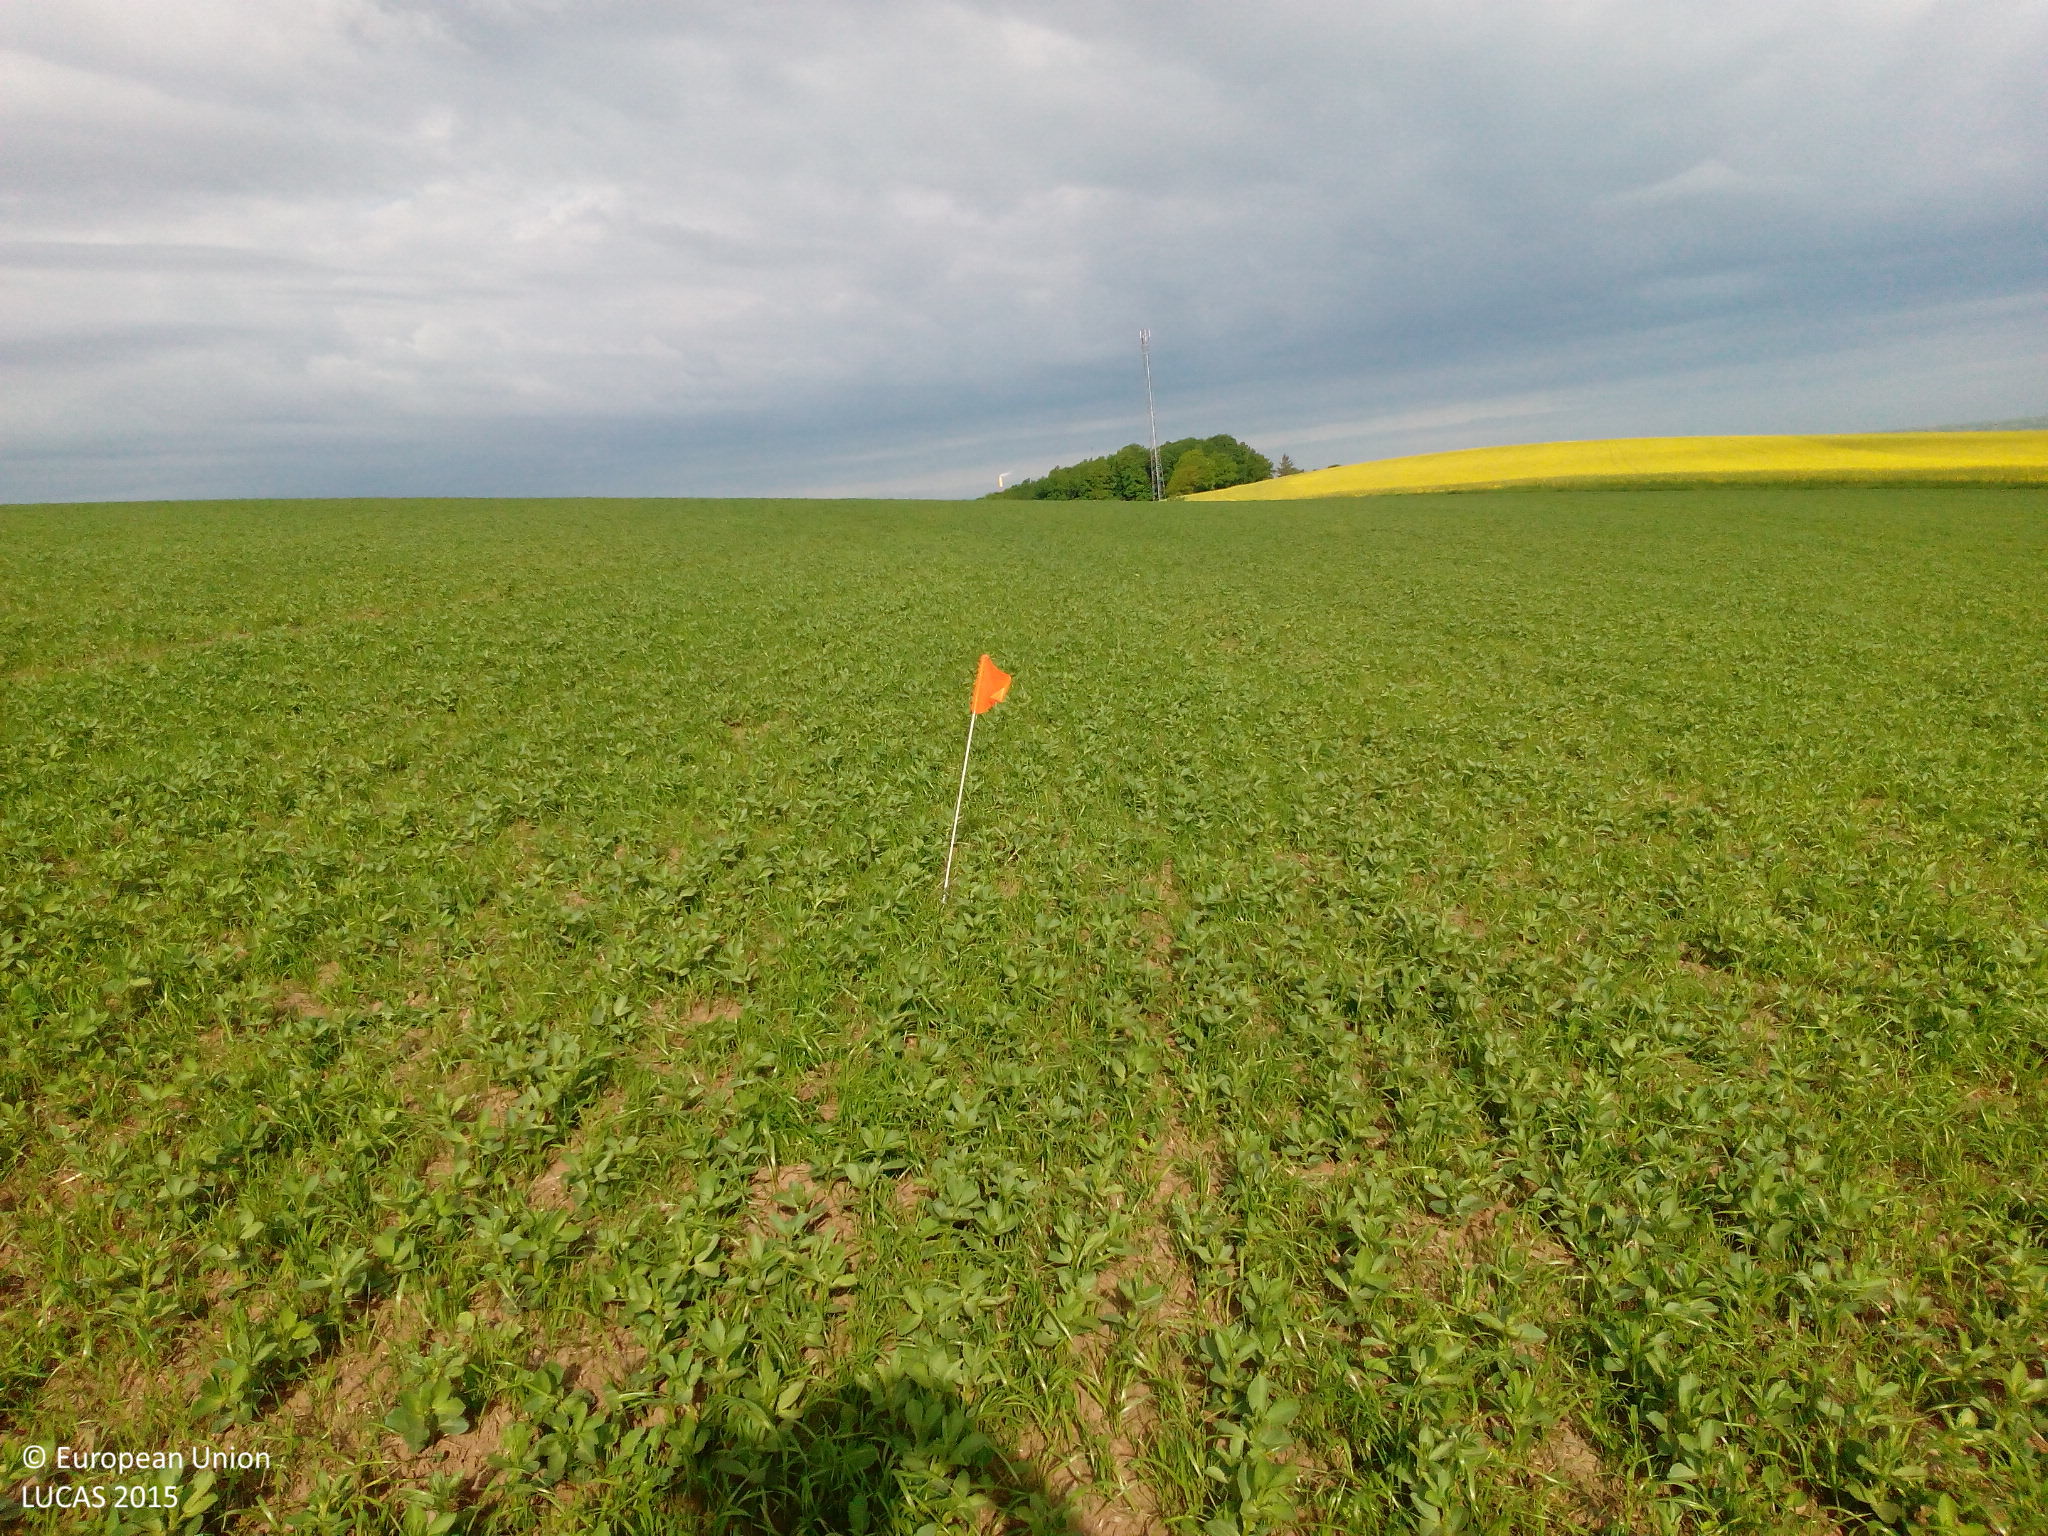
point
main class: Cropland
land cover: Sunflower
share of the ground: 25 - 50 %
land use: Agriculture (excluding fallow land and kitchen gardens)
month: May
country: DE
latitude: 50.8459
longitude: 13.0252
